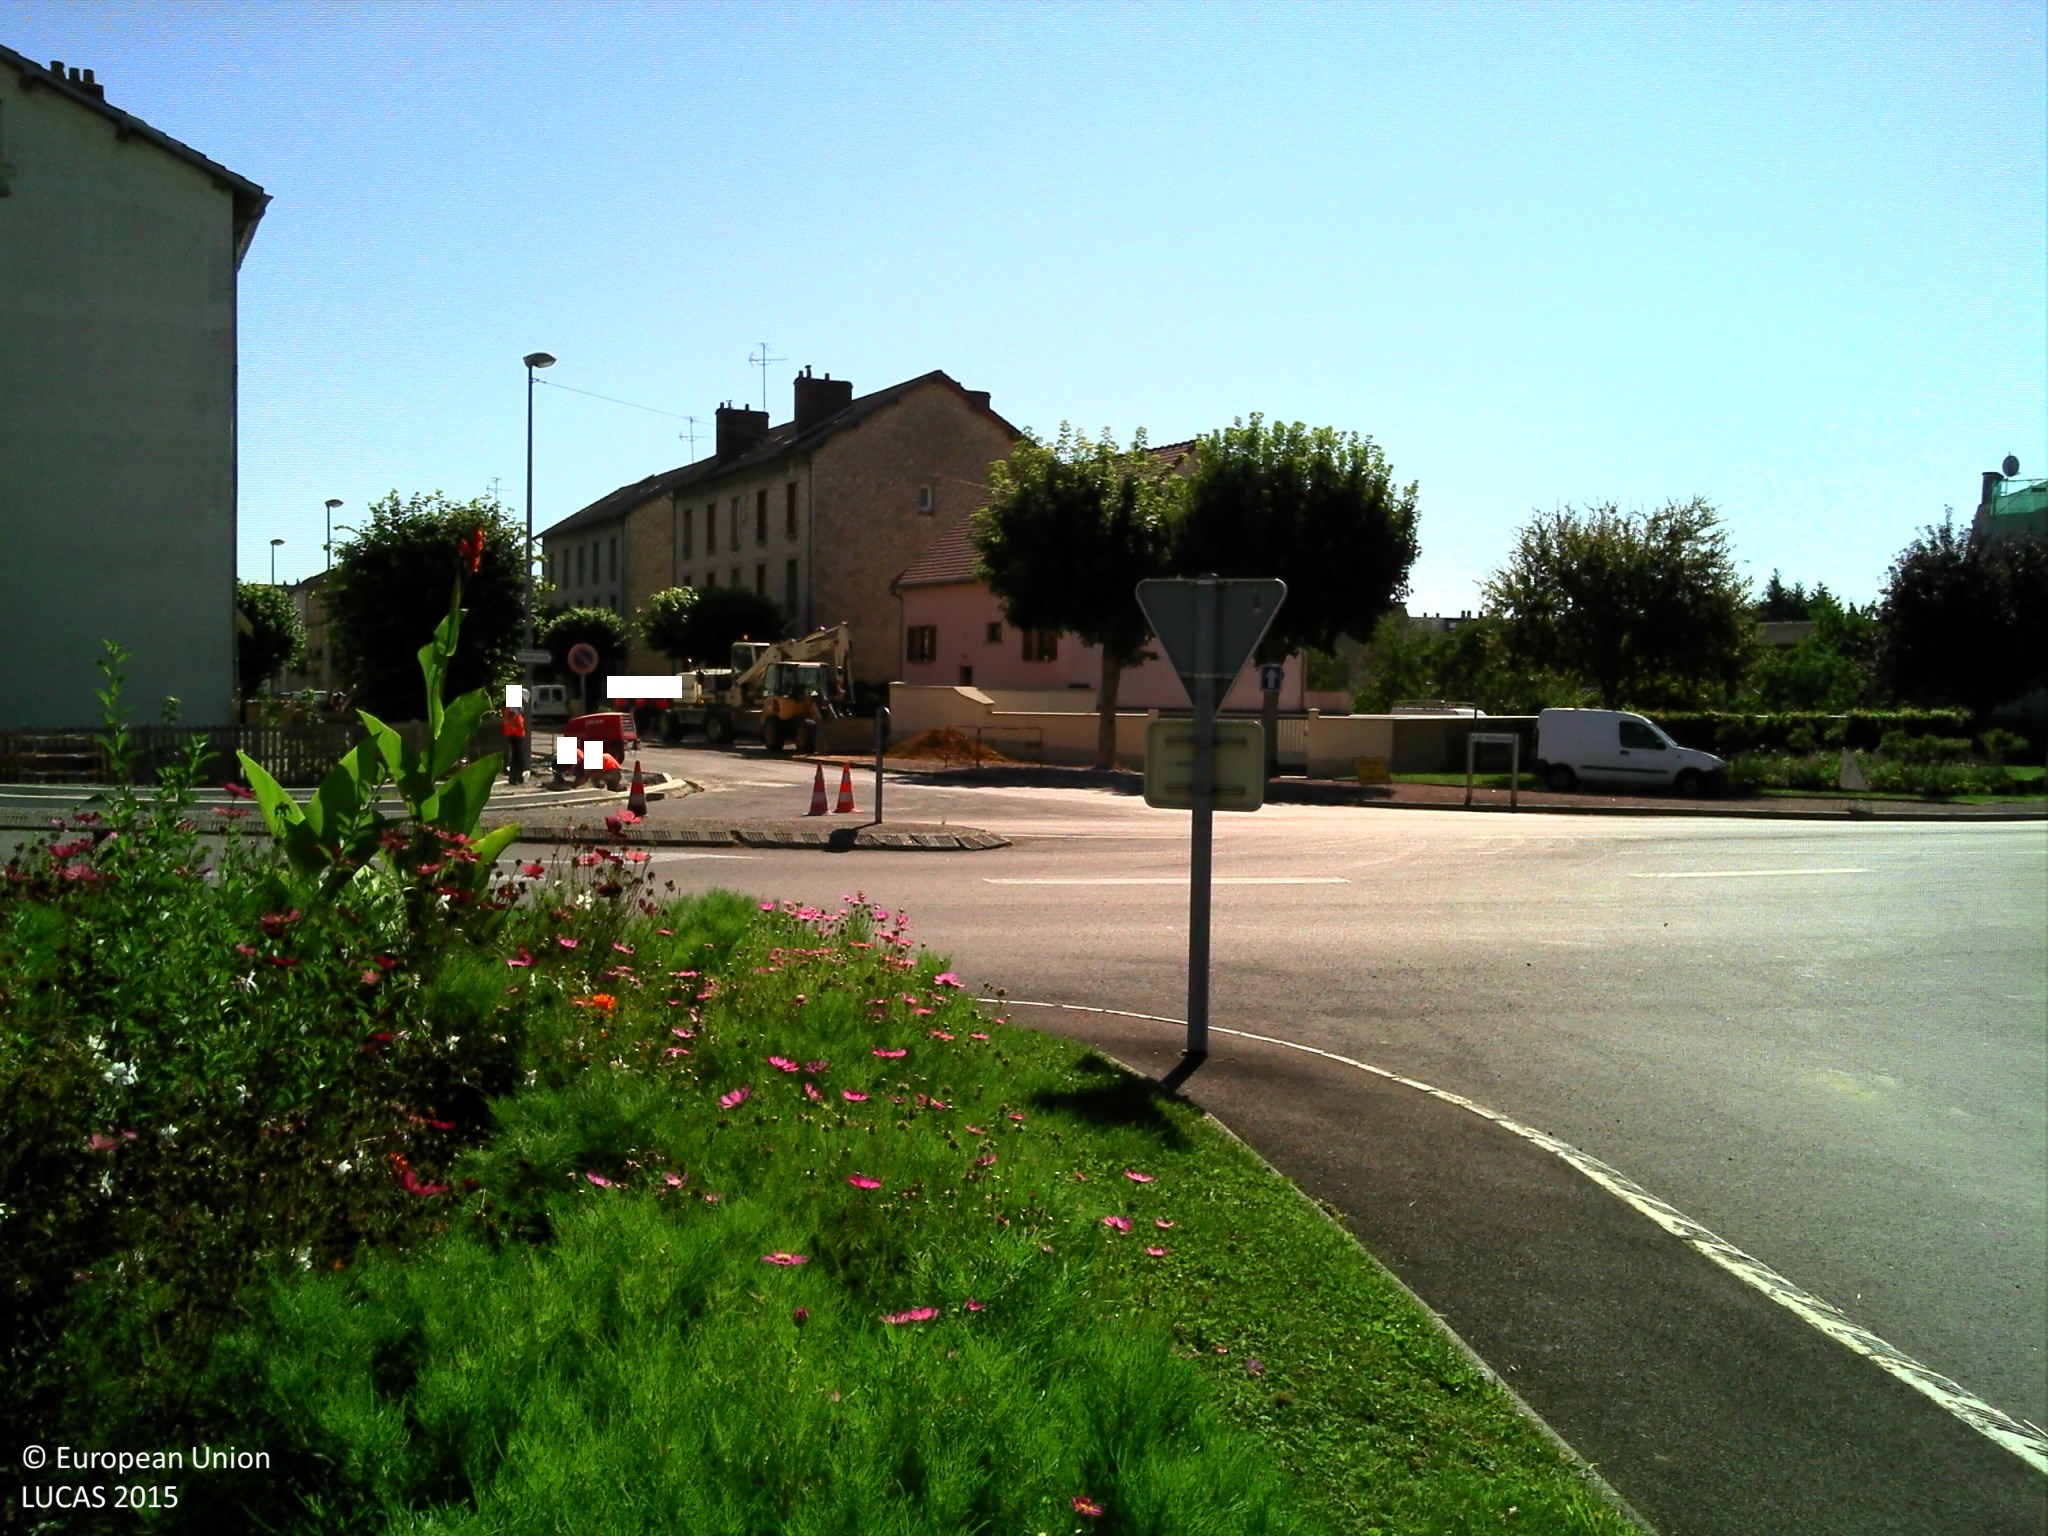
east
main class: Cropland
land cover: Floriculture and ornamental plants
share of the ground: > 75 %
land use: Community services
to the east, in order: Floriculture and ornamental plants; Artificial constructions in urban areas
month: August
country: FR
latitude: 47.9610
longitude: 3.5266
